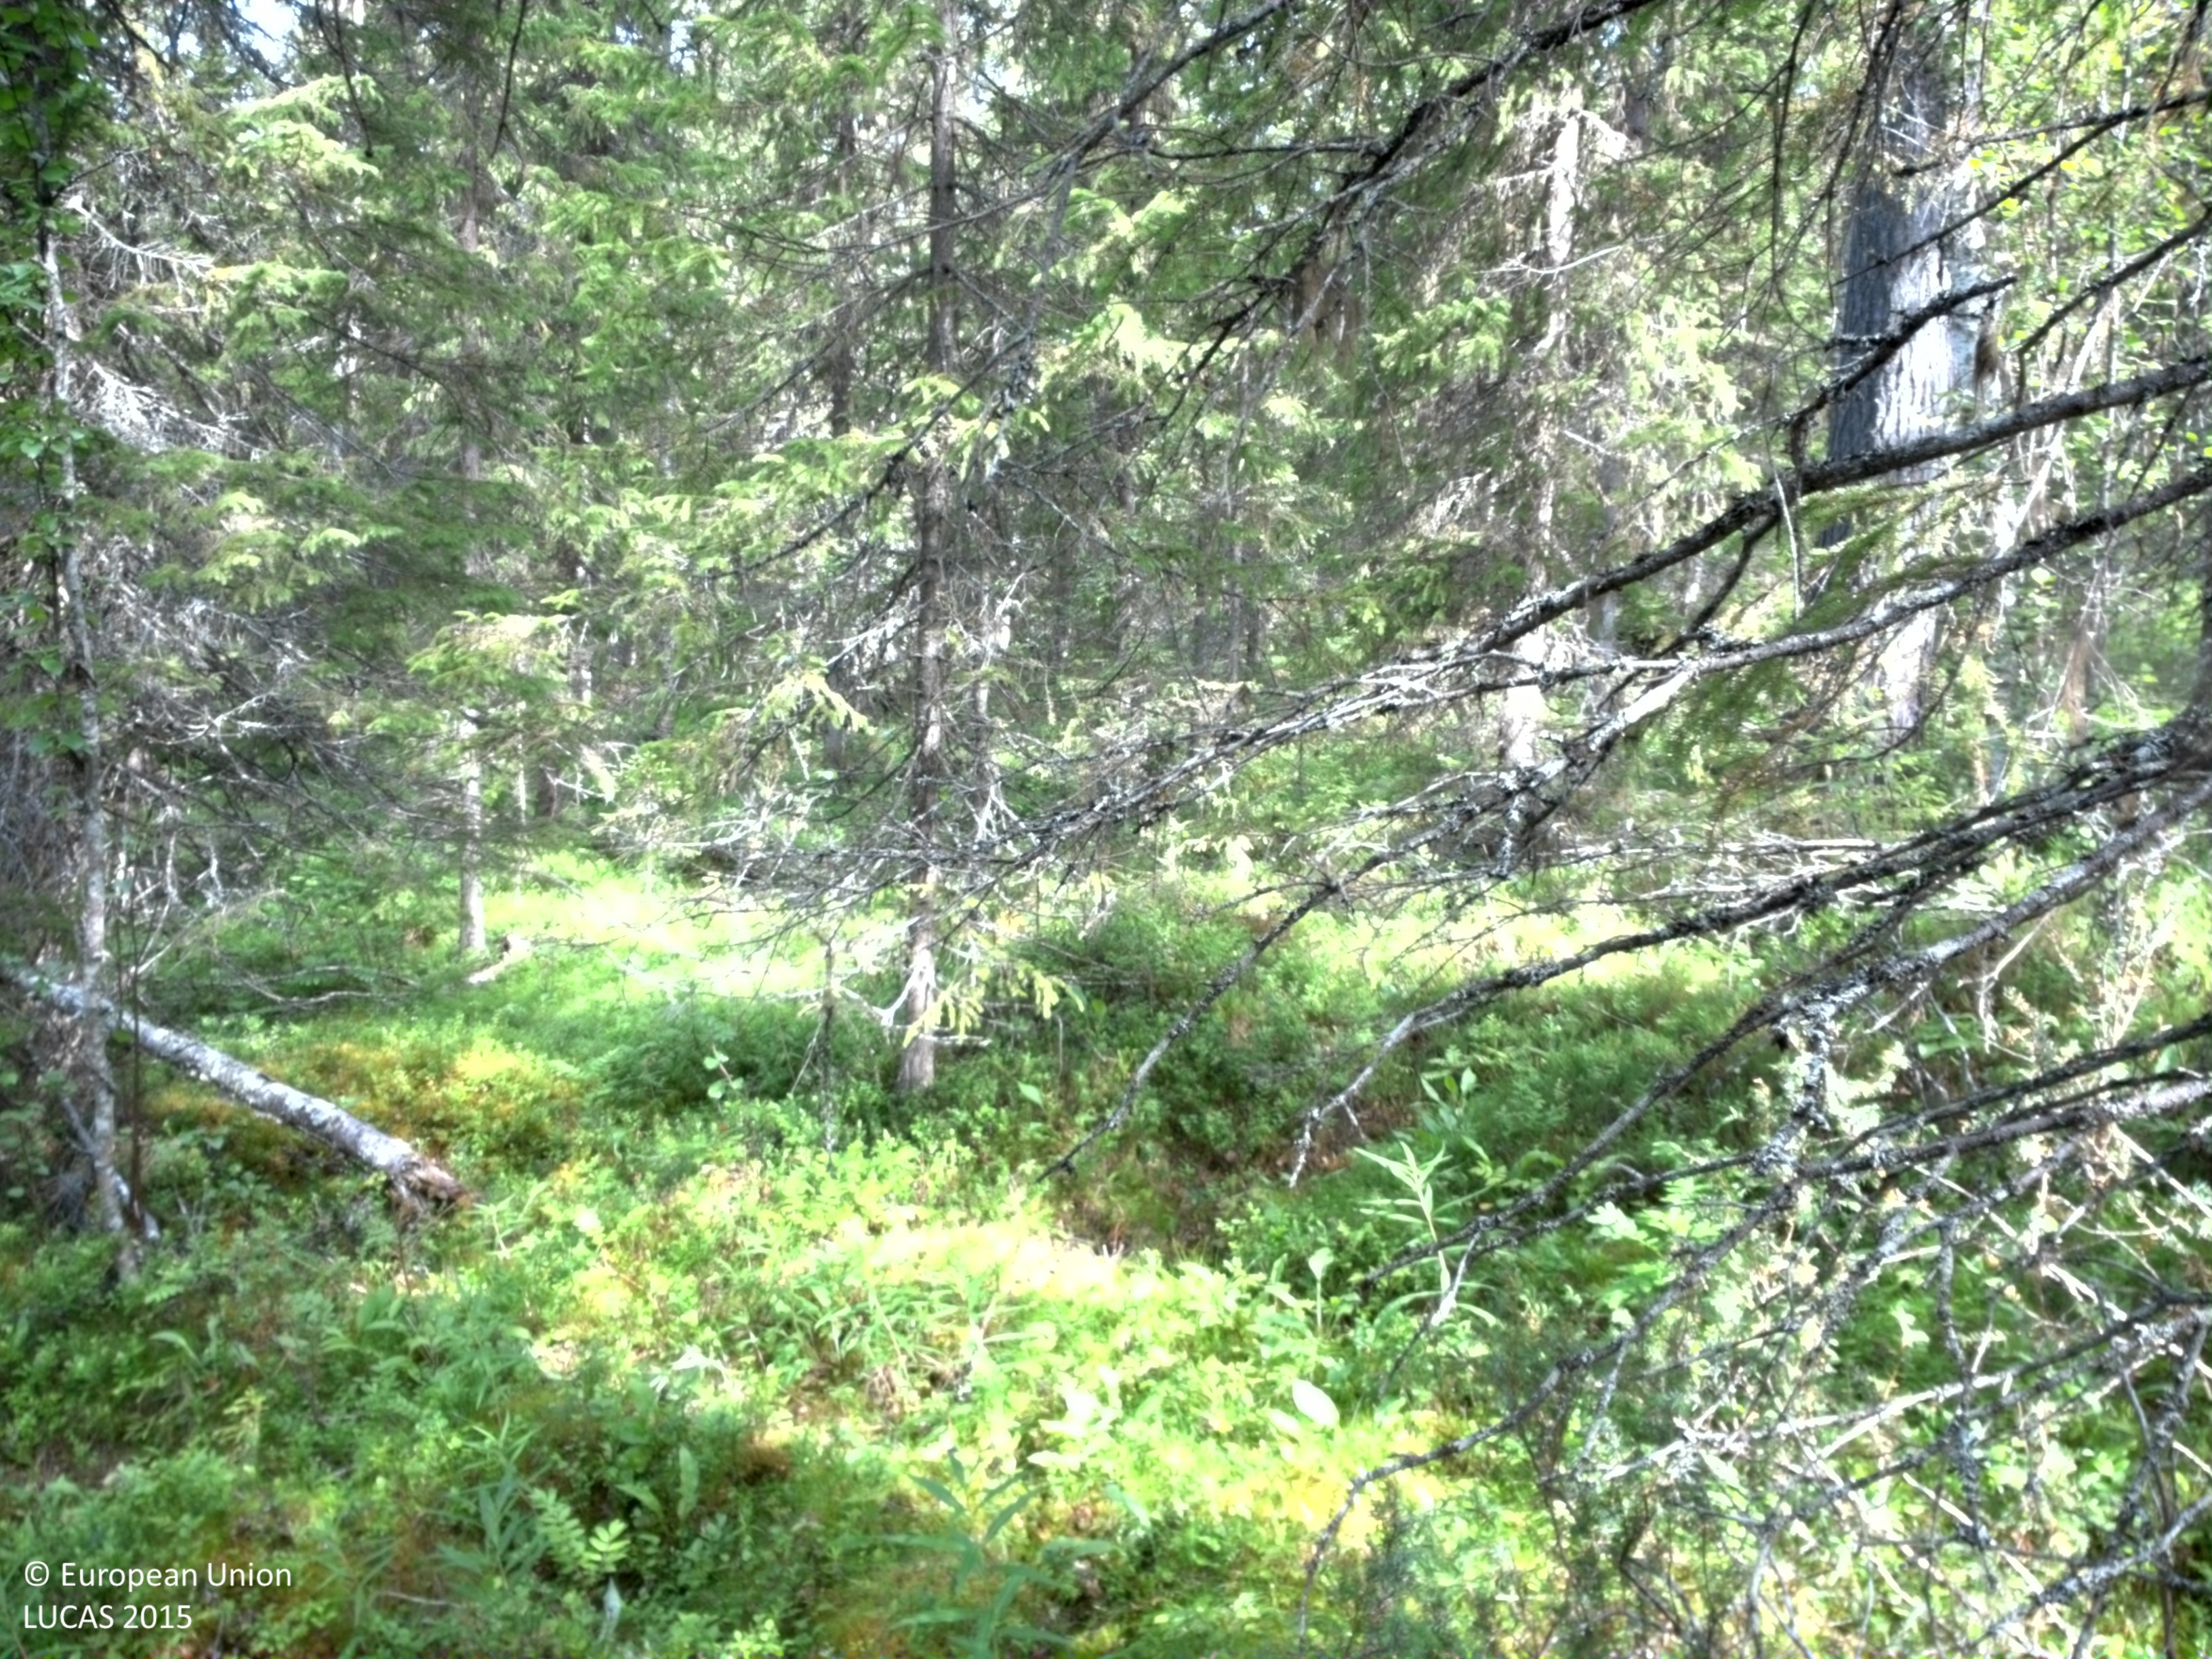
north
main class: Woodland
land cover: Spruce dominated coniferous woodland
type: boreal forest
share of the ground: 50 - 75 %
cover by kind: coniferous forest trees 50 %, shrubs 35 %, lichens and mosses 10 %, herbaceous plants 5 %
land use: Forestry
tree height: > 5 m
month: August
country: SE
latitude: 64.9386
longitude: 15.9541
